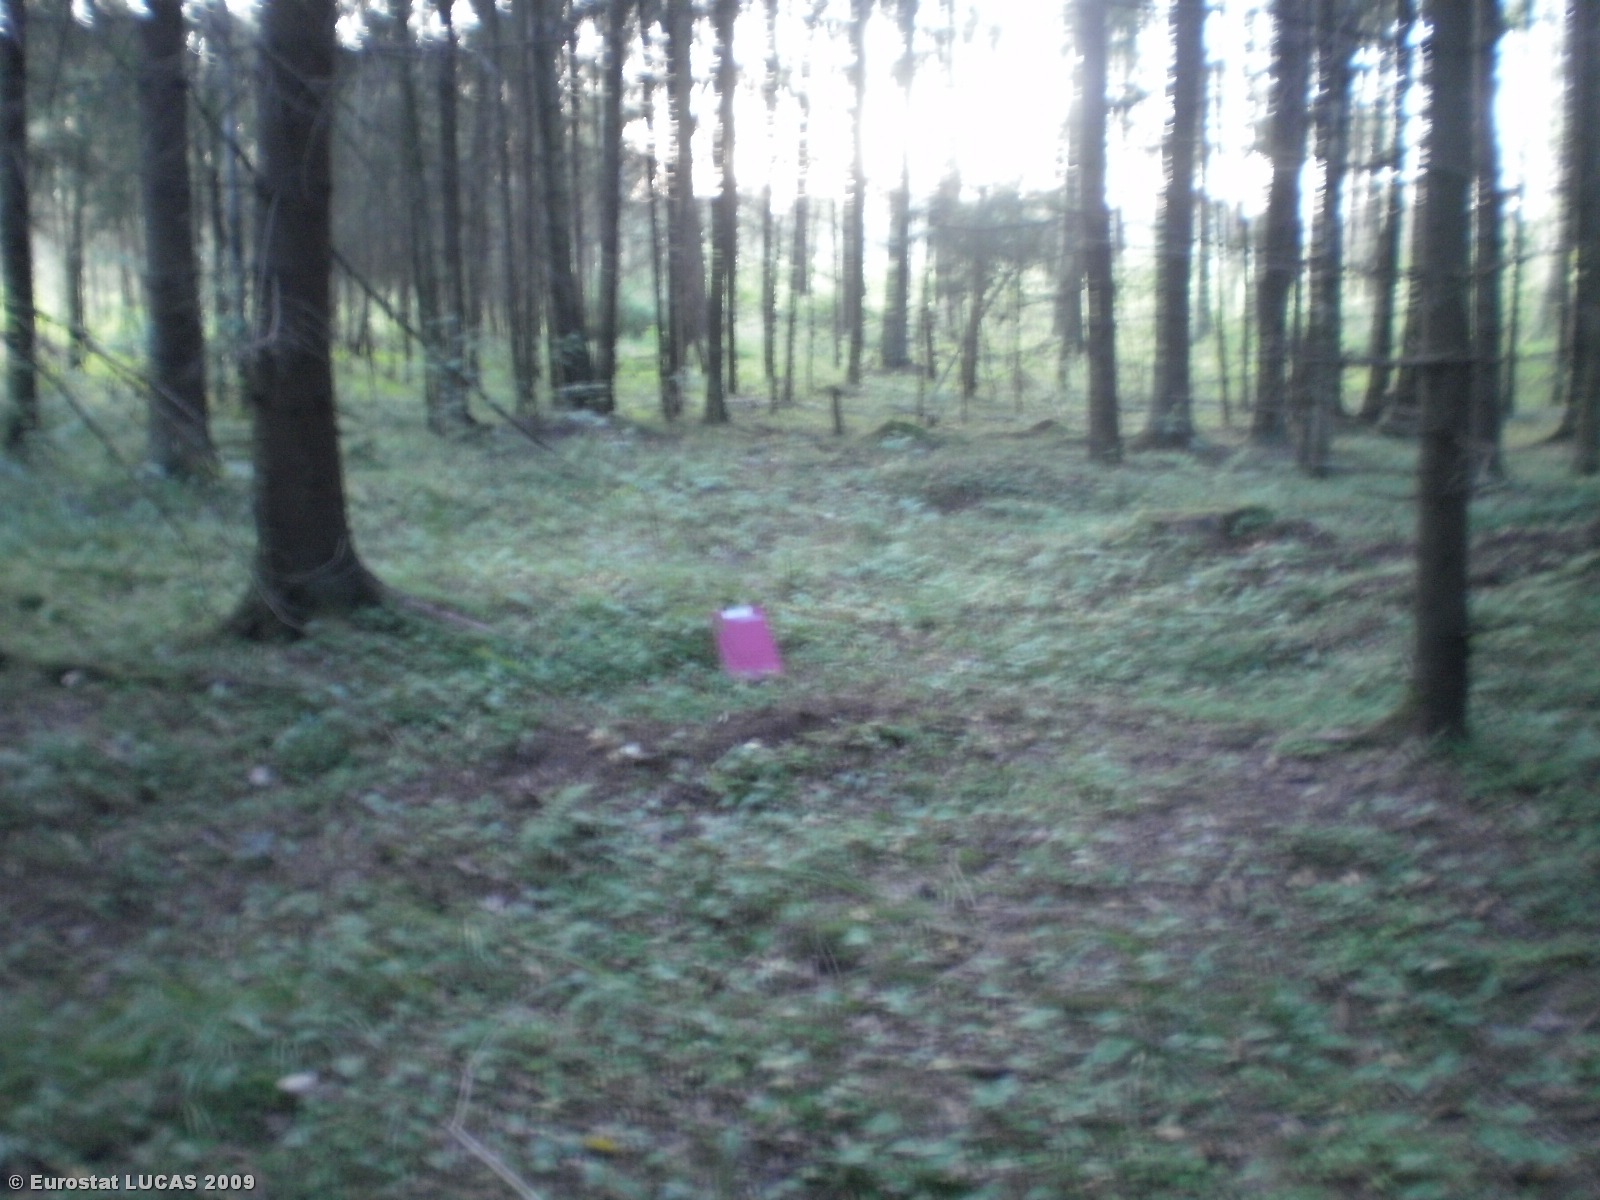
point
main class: Woodland
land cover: Coniferous woodland
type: boreal forest
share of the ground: 25 - 50 %
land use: Forestry
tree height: > 5 m
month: July
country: LT
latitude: 55.9083
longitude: 25.2658
